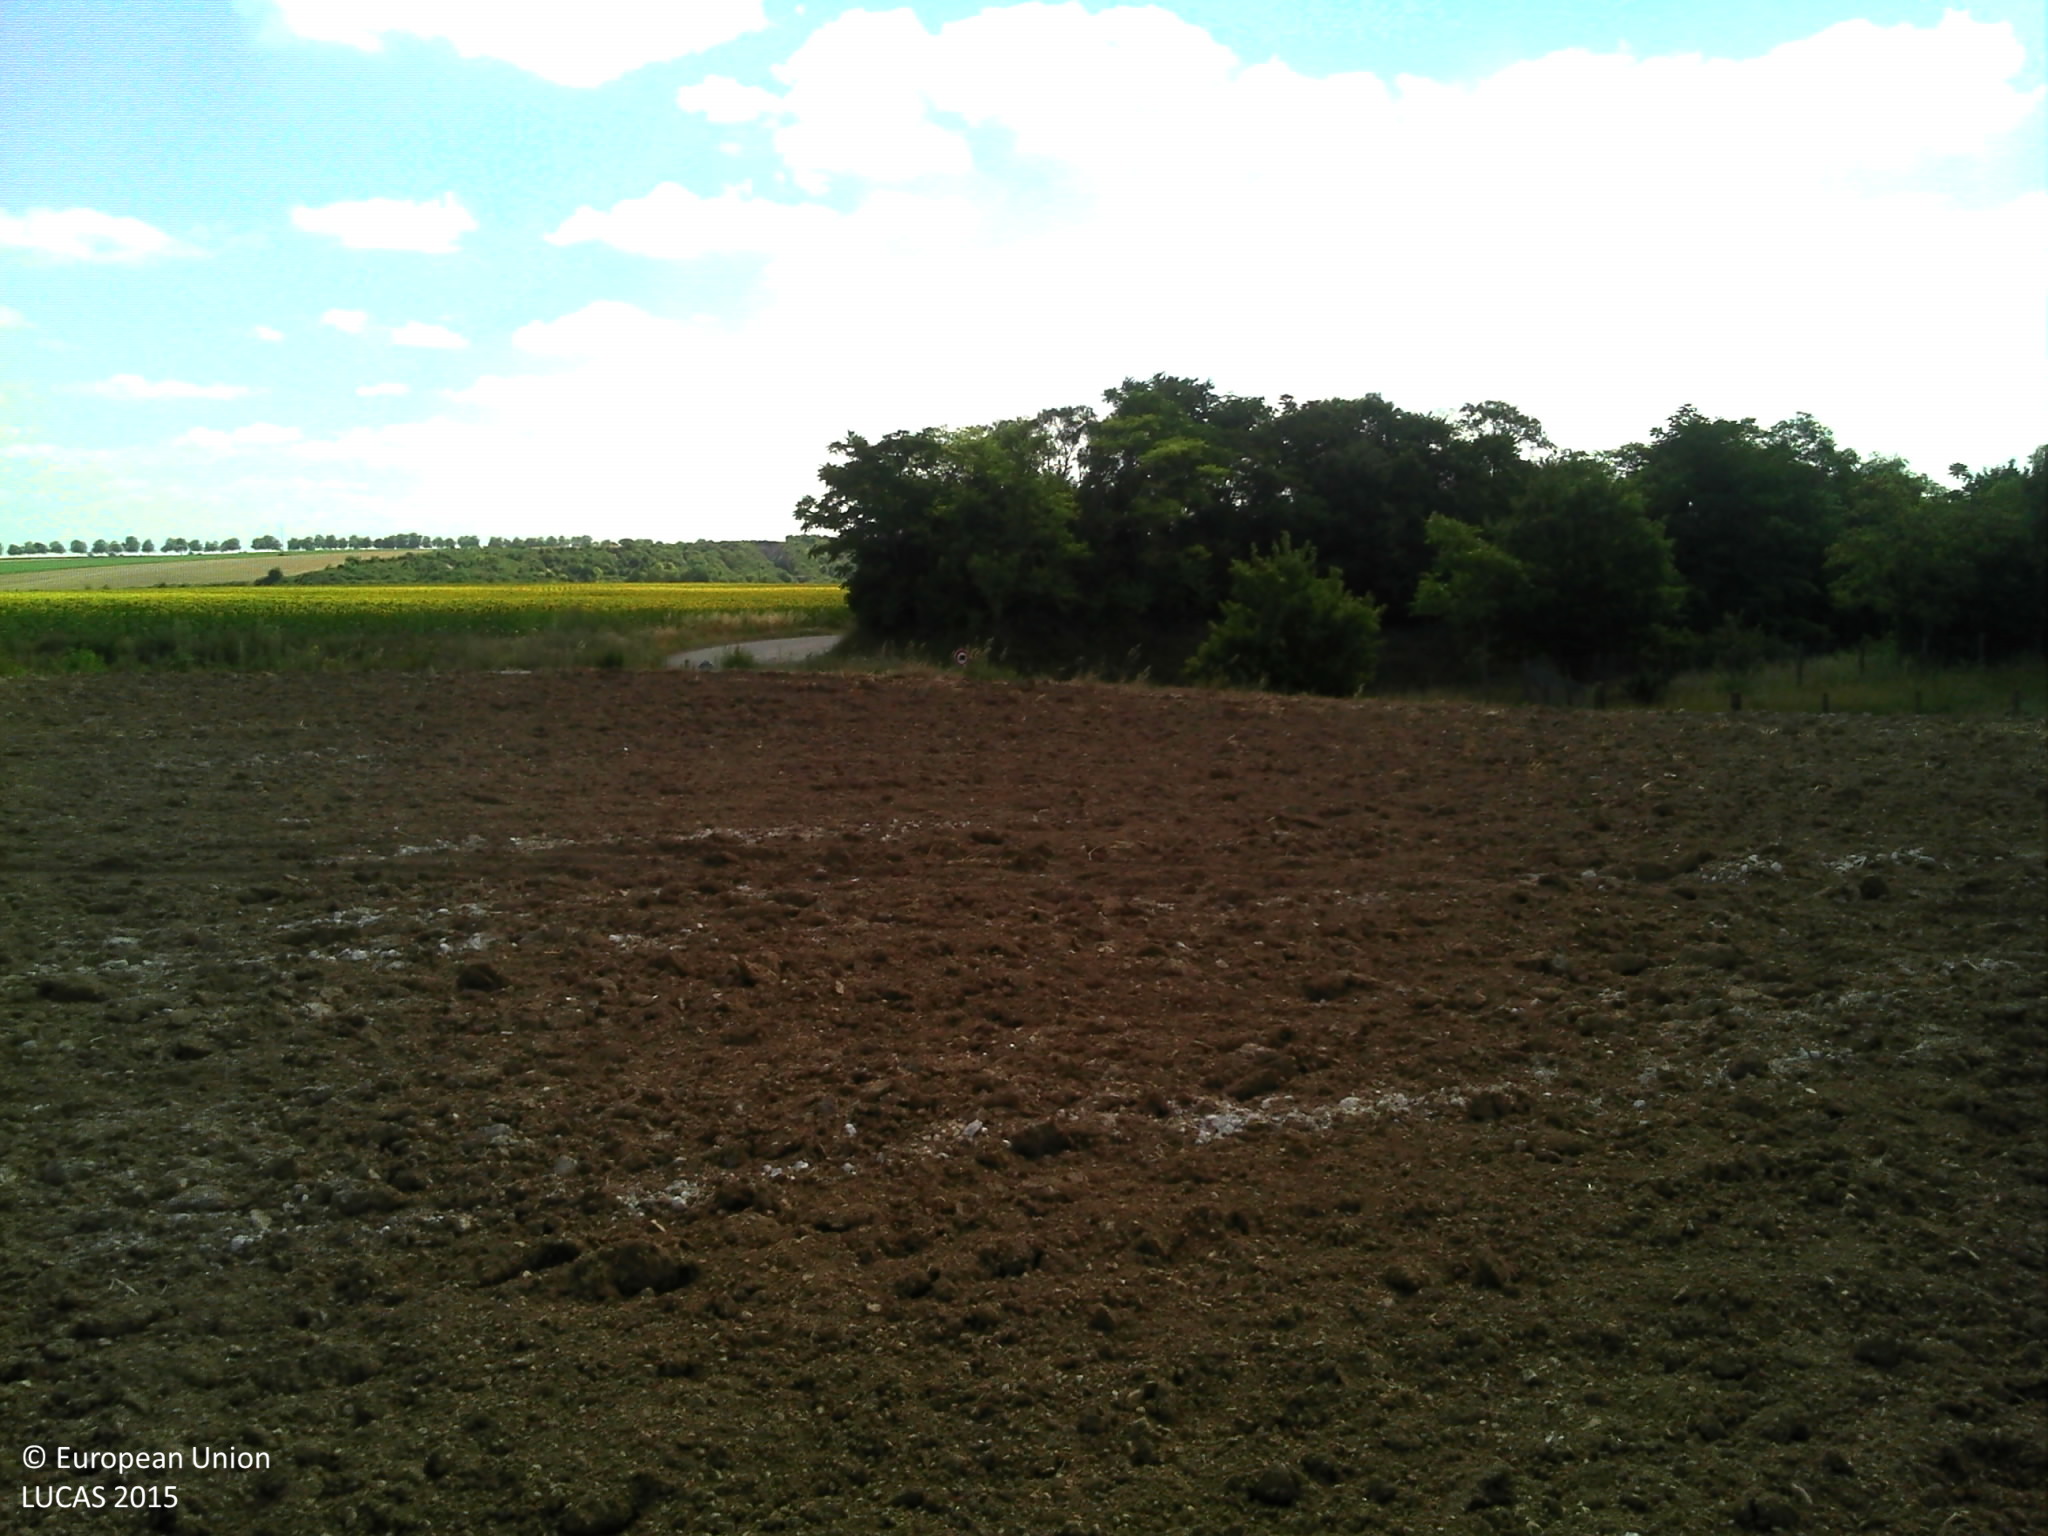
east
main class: Cropland
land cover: Sunflower
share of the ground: > 75 %
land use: Agriculture (excluding fallow land and kitchen gardens)
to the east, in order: Sunflower; Other structural elements; Other bare soil; Grass margins; Ditches and canals; Grass margins; Paved roads, cycling and walking lanes; Grass margins; Broadleaved woodland; Grass margins; Paved roads, cycling and walking lanes; Grass margins; Sunflower
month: July
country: FR
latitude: 46.6325
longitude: 0.2751
